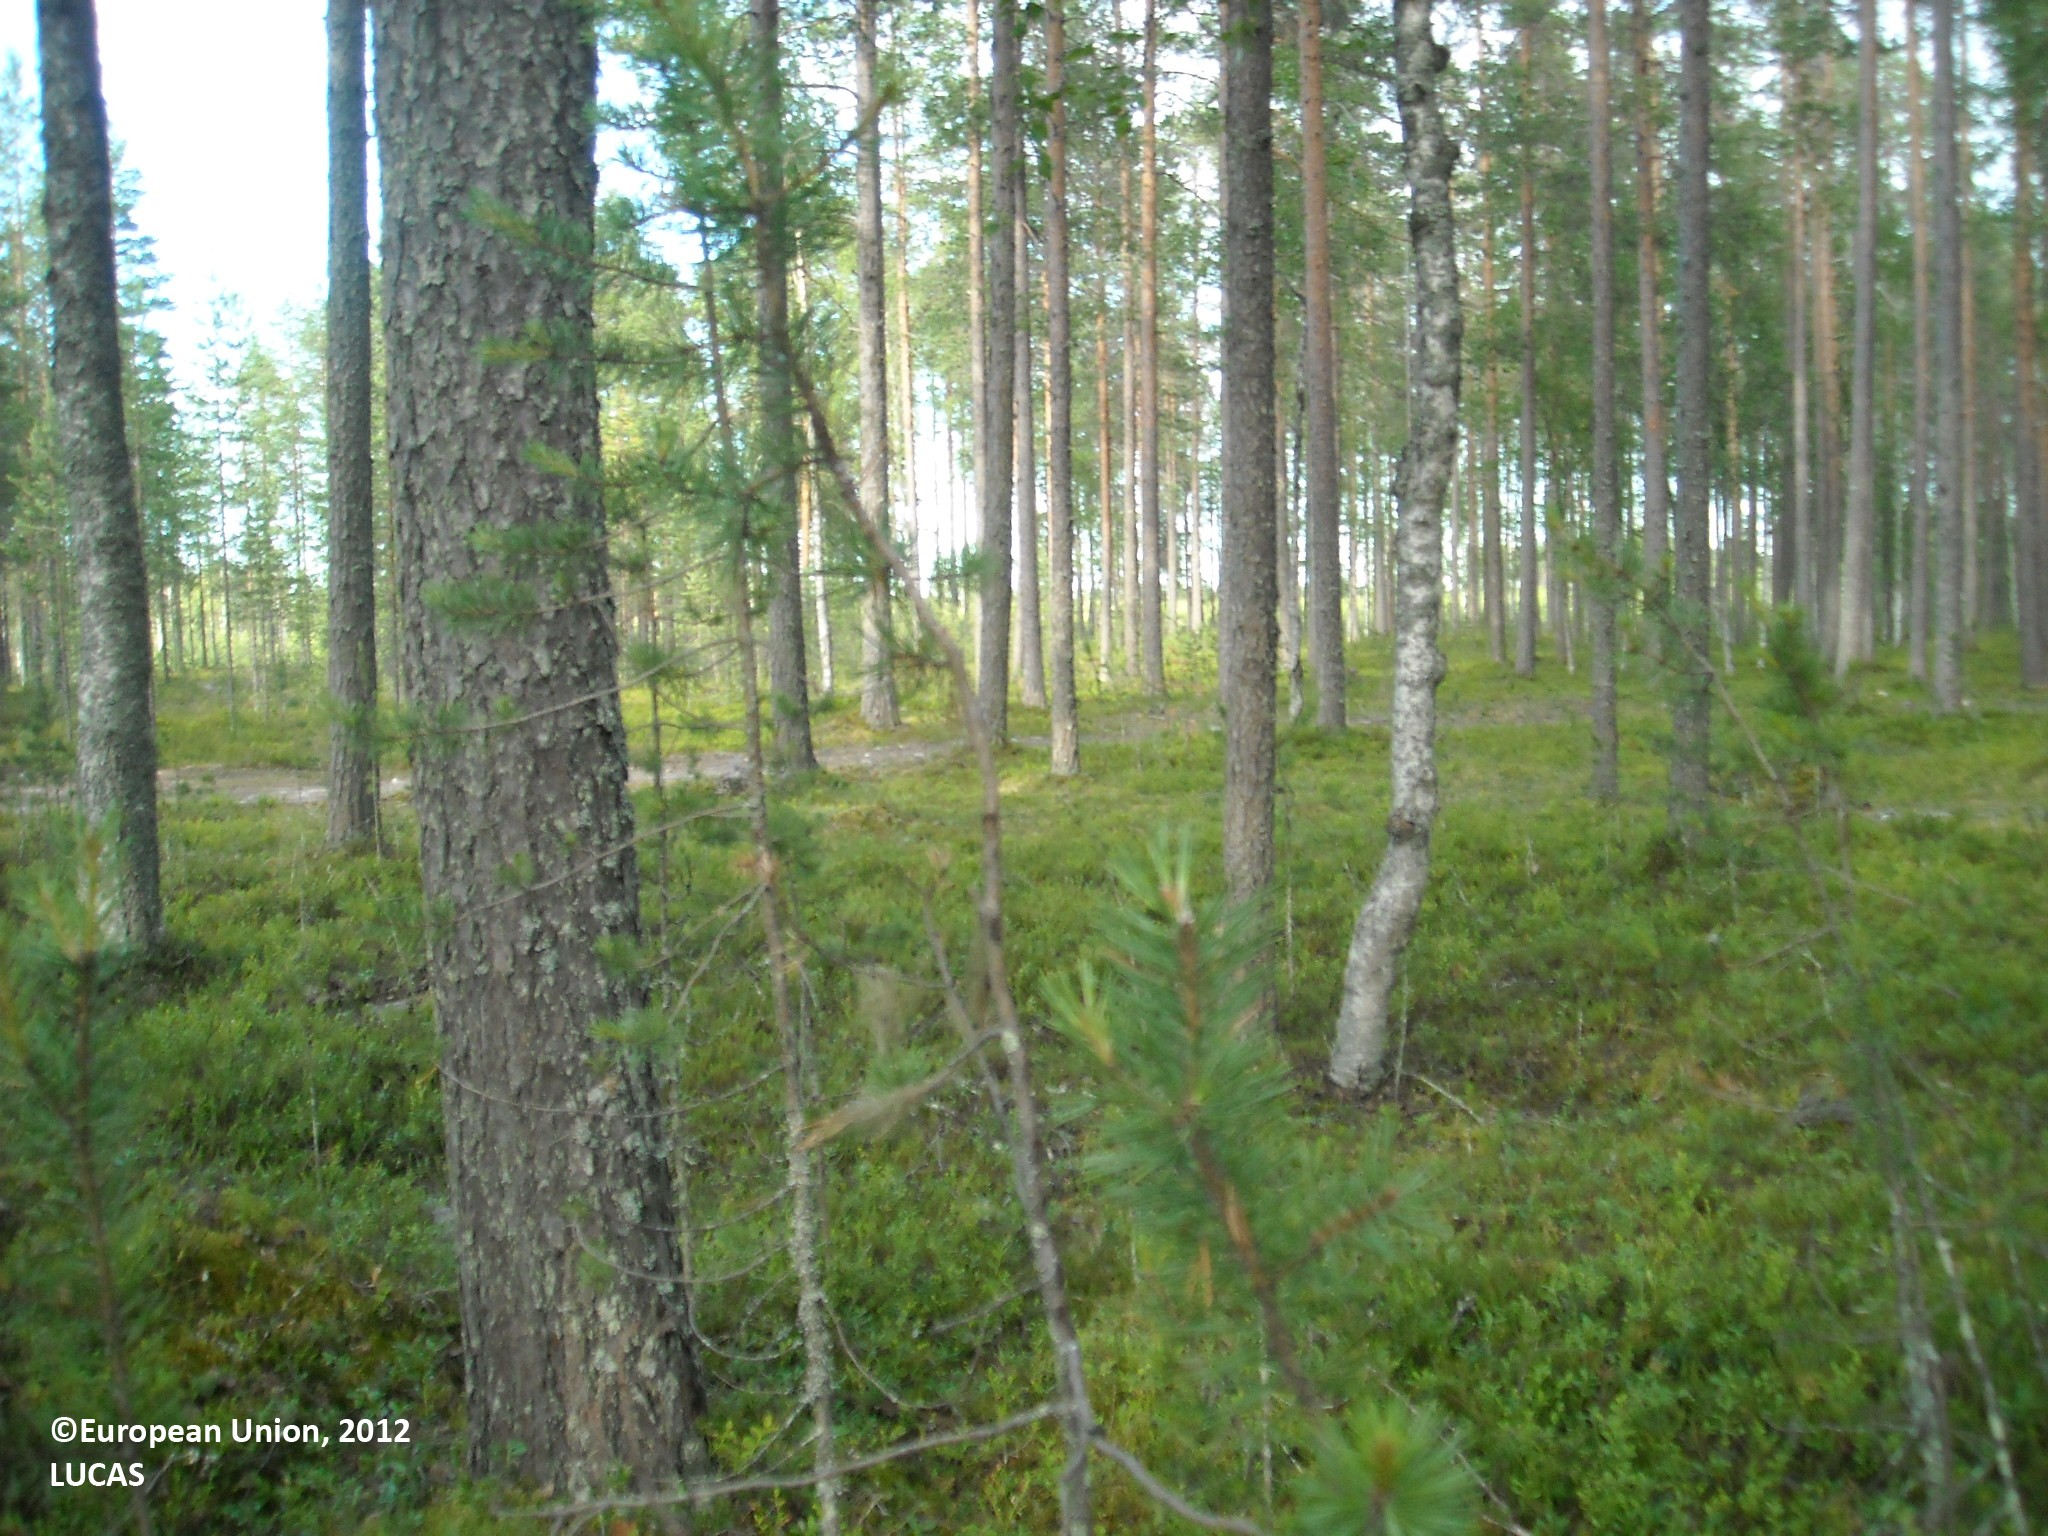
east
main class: Woodland
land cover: Pine dominated mixed woodland
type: boreal forest
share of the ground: 50 - 75 %
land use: Forestry
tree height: > 5 m
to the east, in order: Pine dominated mixed woodland; Paved roads, cycling and walking lanes; Pine dominated mixed woodland; Shrubland with sparse tree cover; Pine dominated coniferous woodland
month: July
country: FI
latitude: 65.0834
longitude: 26.8585
